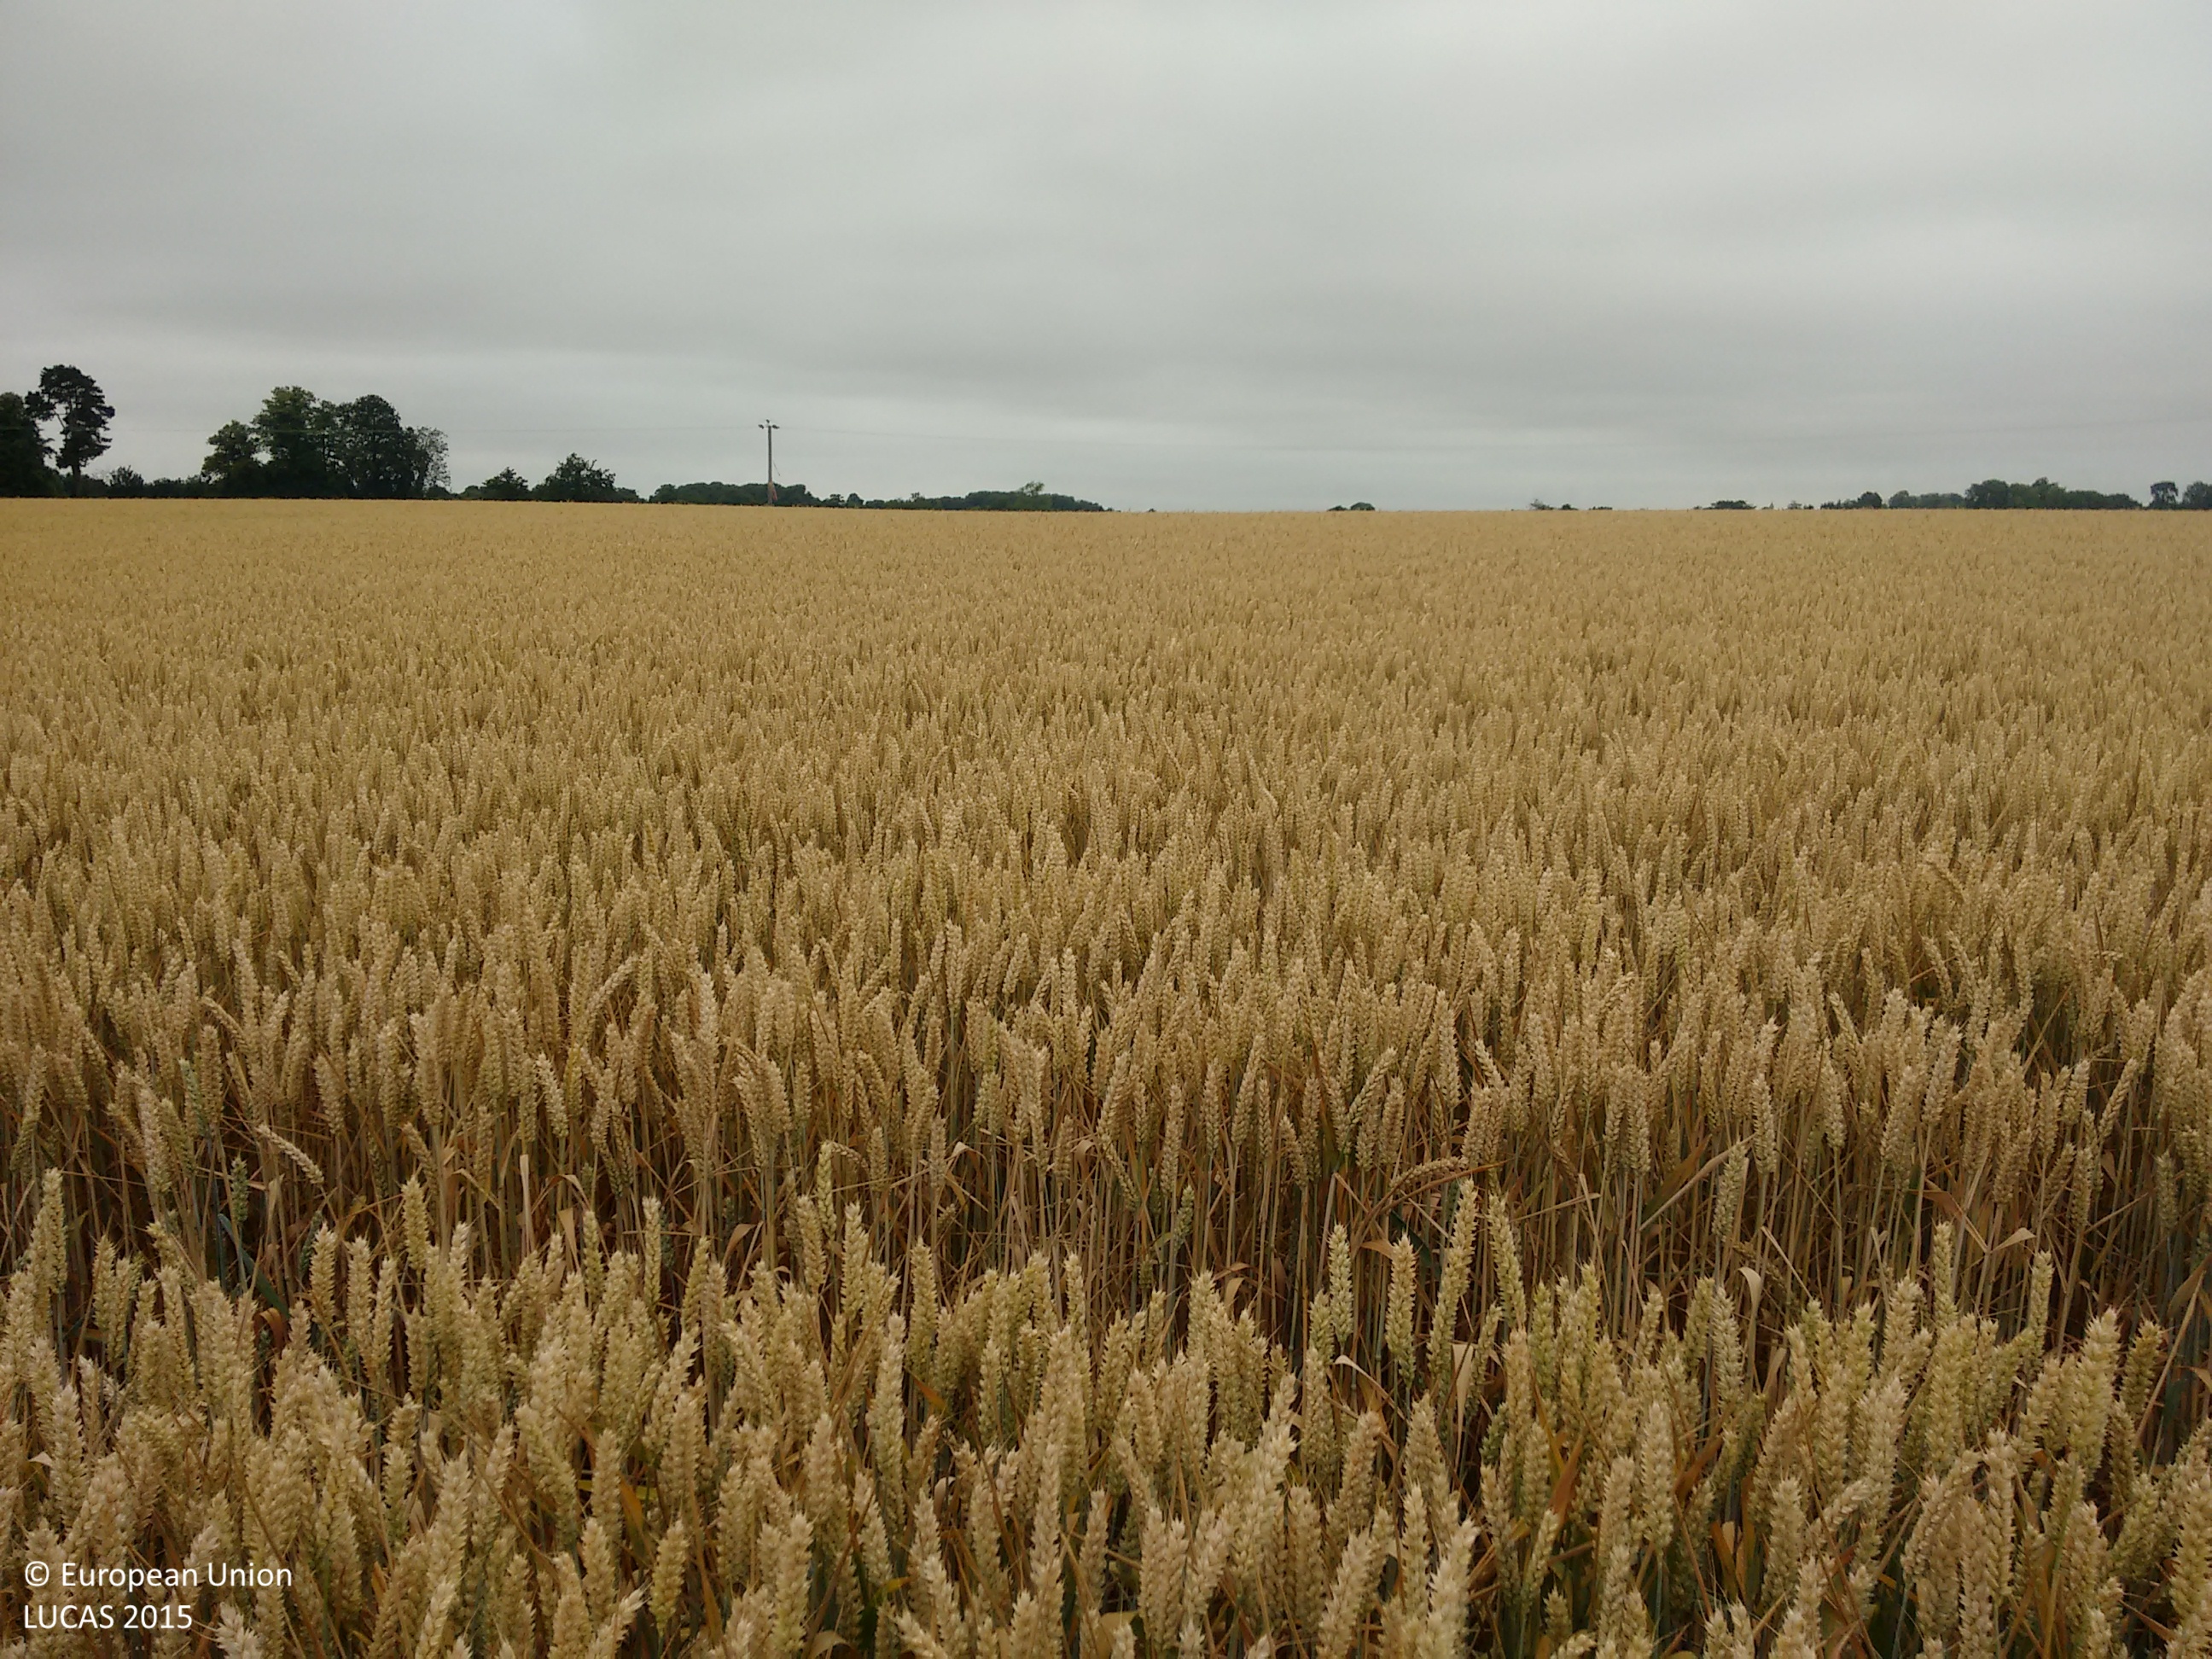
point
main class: Cropland
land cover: Common wheat
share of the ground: > 75 %
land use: Agriculture (excluding fallow land and kitchen gardens)
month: July
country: GB
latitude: 51.8183
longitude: 0.3233
